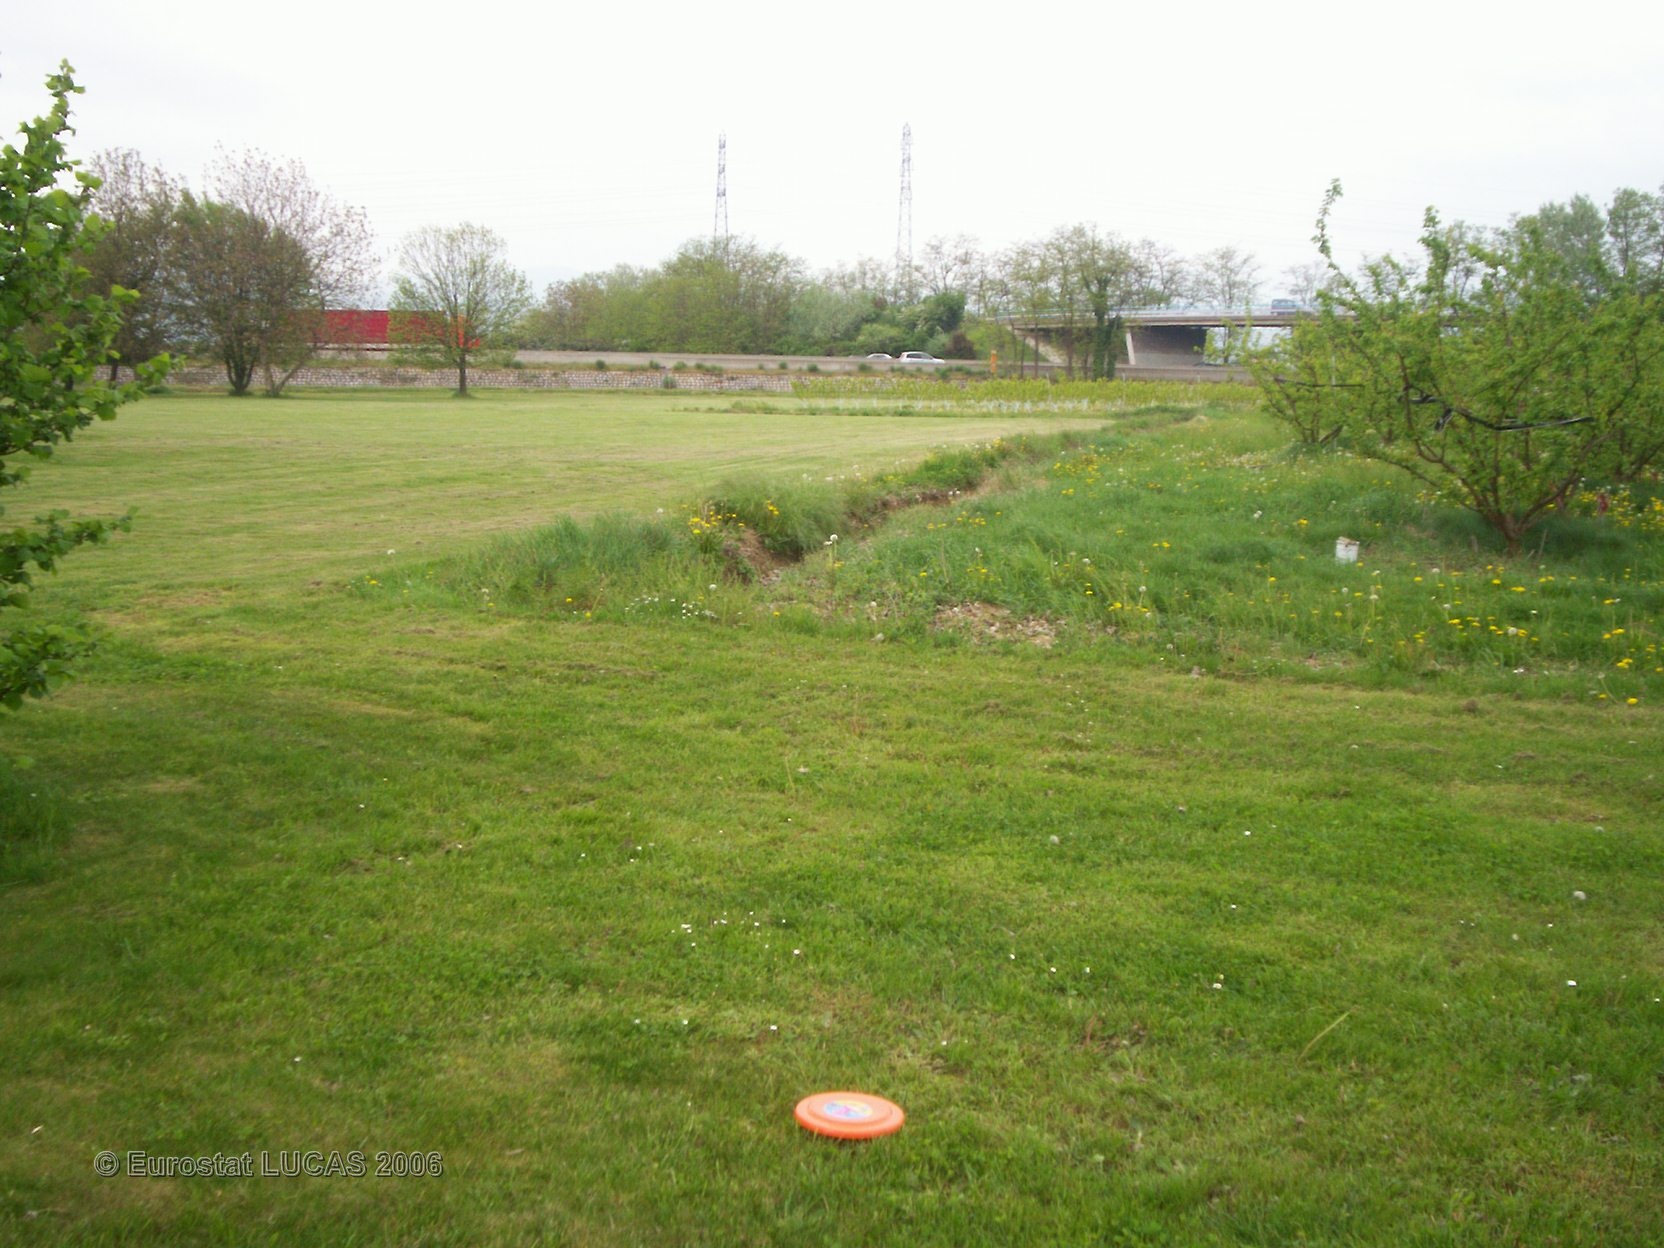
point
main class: Grassland
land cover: Grassland with sparse tree/shrub cover
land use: Amenities, museums, leisure
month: April
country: FR
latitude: 45.3407
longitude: 4.8106
